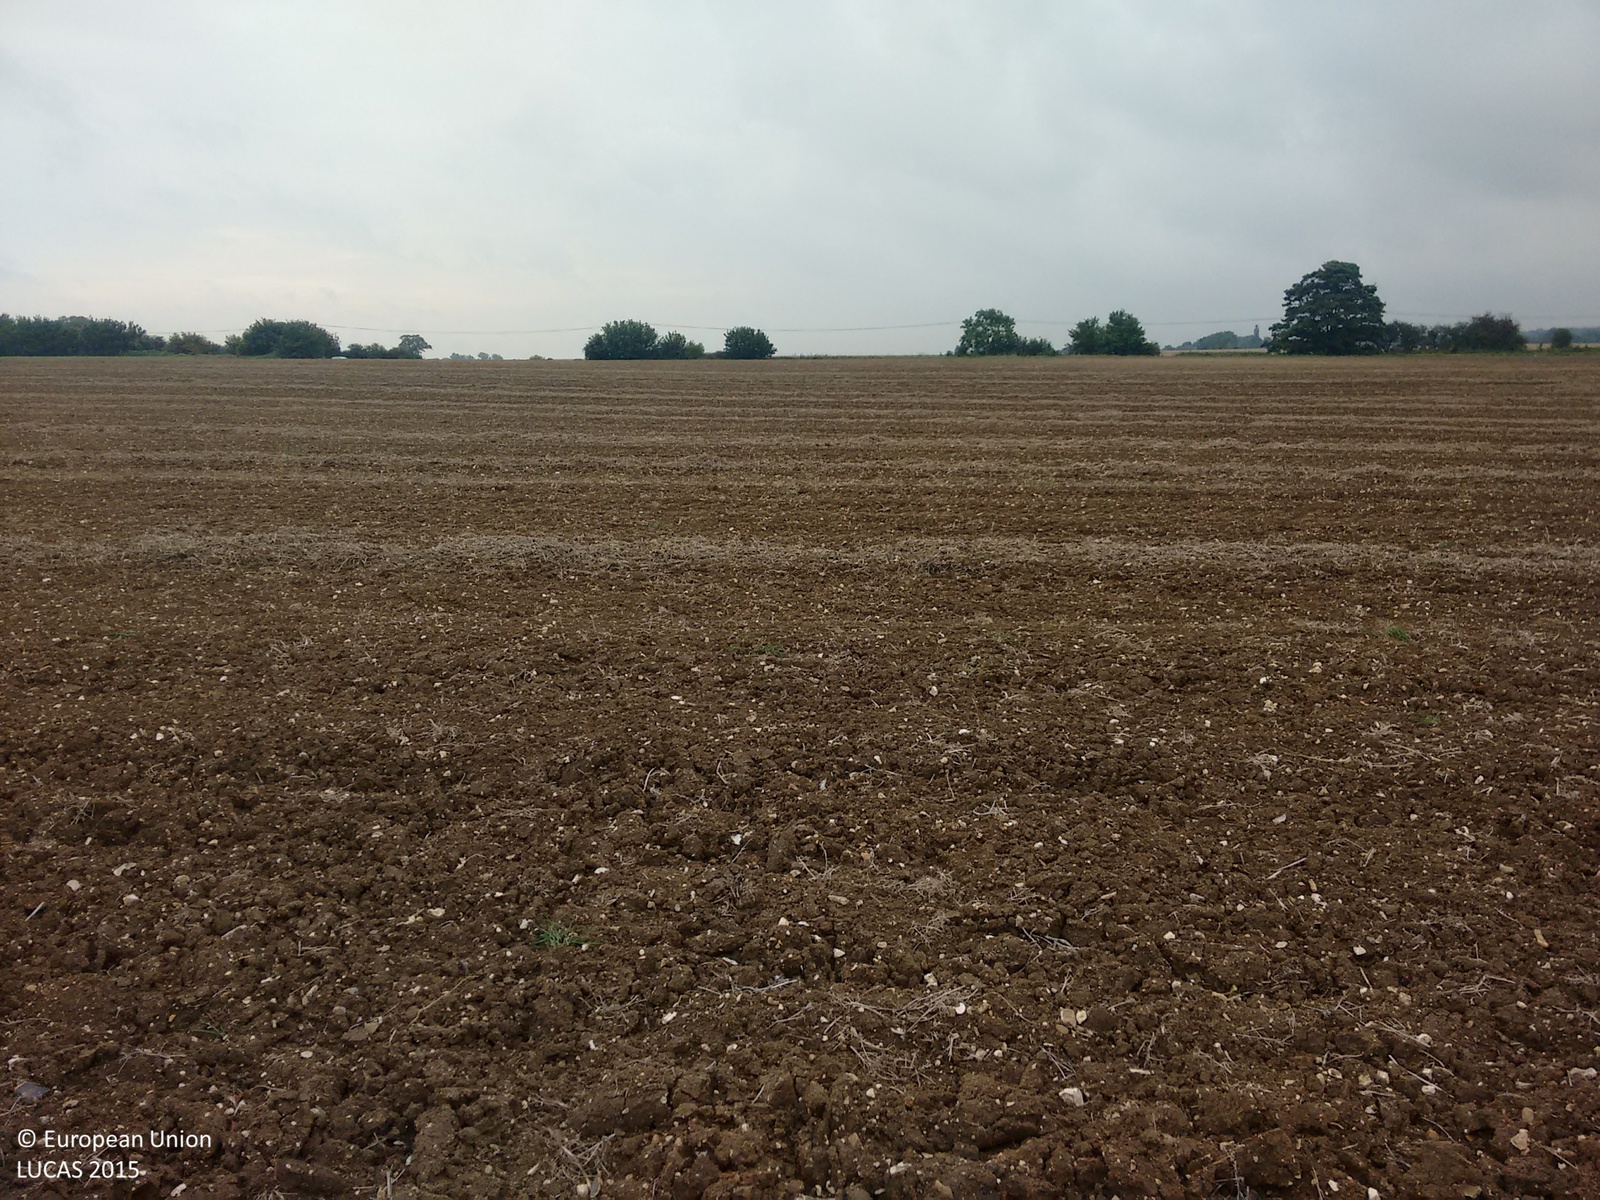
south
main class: Cropland
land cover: Dry pulses
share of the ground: < 10 %
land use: Agriculture (excluding fallow land and kitchen gardens)
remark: Harvested field
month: September
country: GB
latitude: 51.9381
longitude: 0.2386
